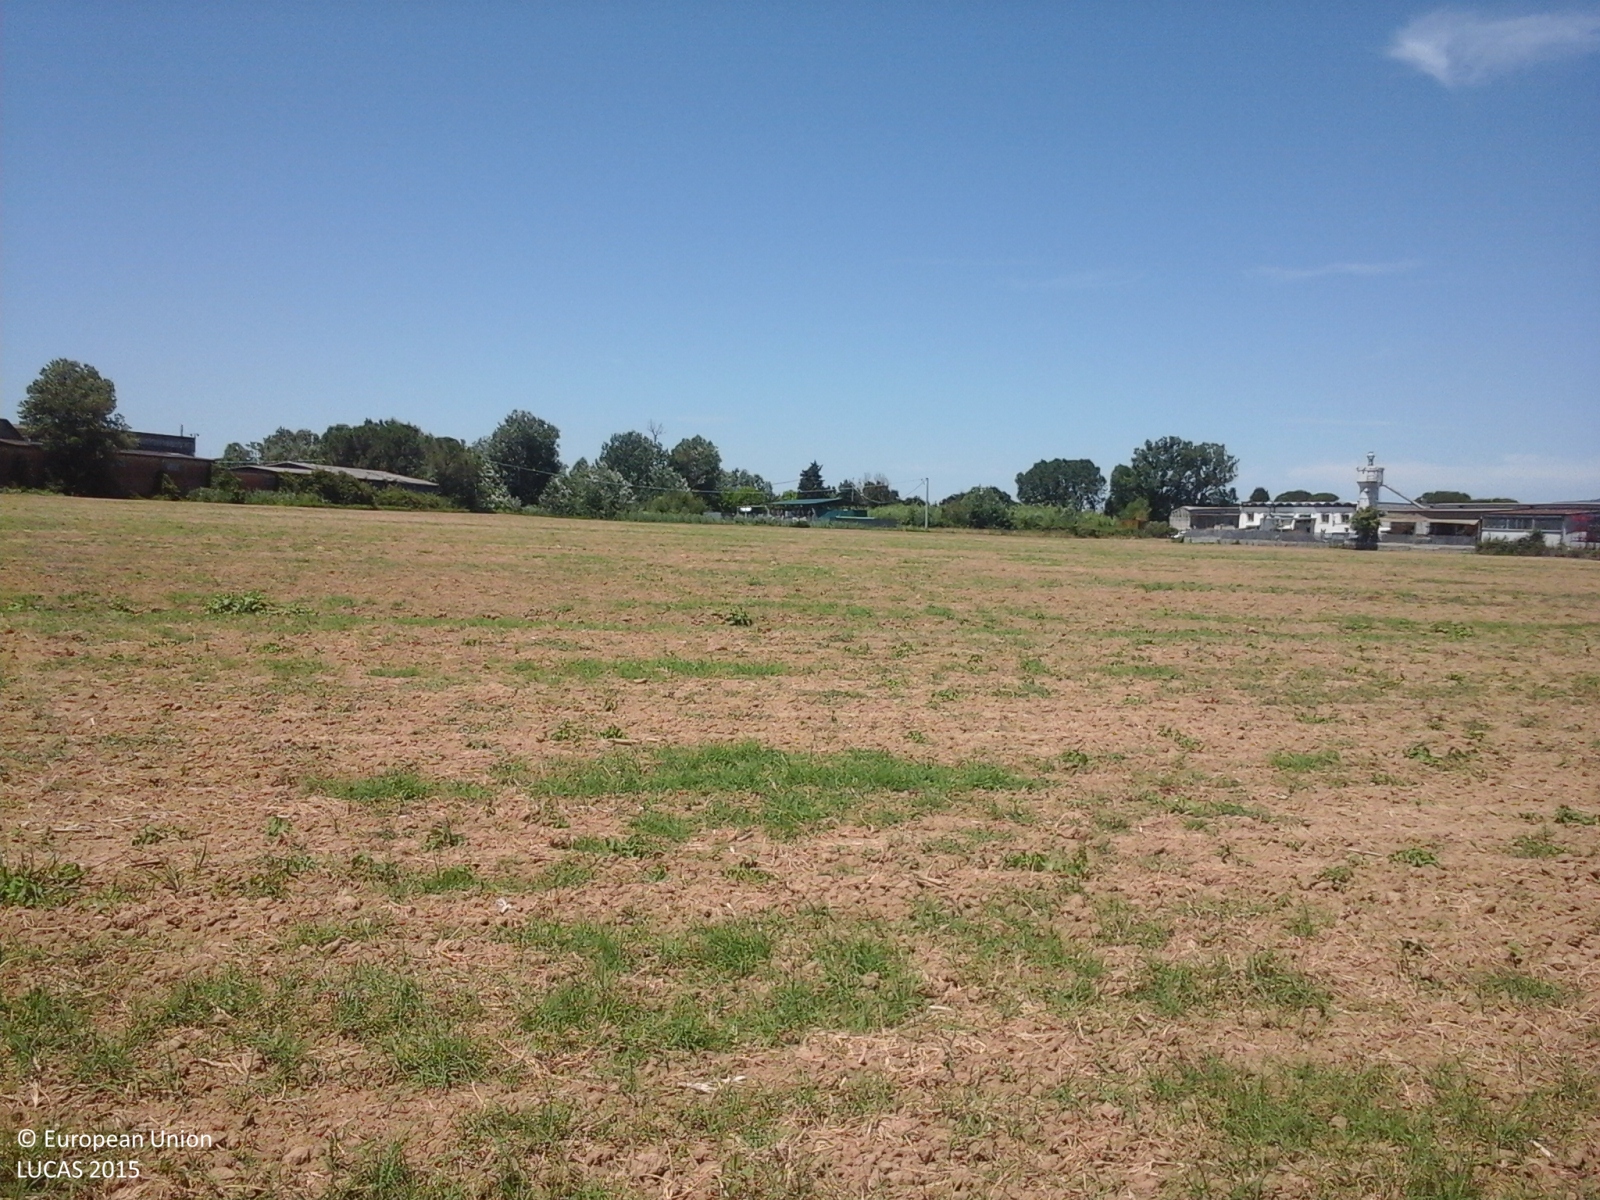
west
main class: Grassland
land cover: Grassland with sparse tree/shrub cover
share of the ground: 50 - 75 %
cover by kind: herbaceous plants 85 %, shrubs 10 %, broadleaved forest trees 5 %
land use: Semi-natural and natural areas not in use
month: June
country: IT
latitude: 43.6091
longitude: 10.6054
